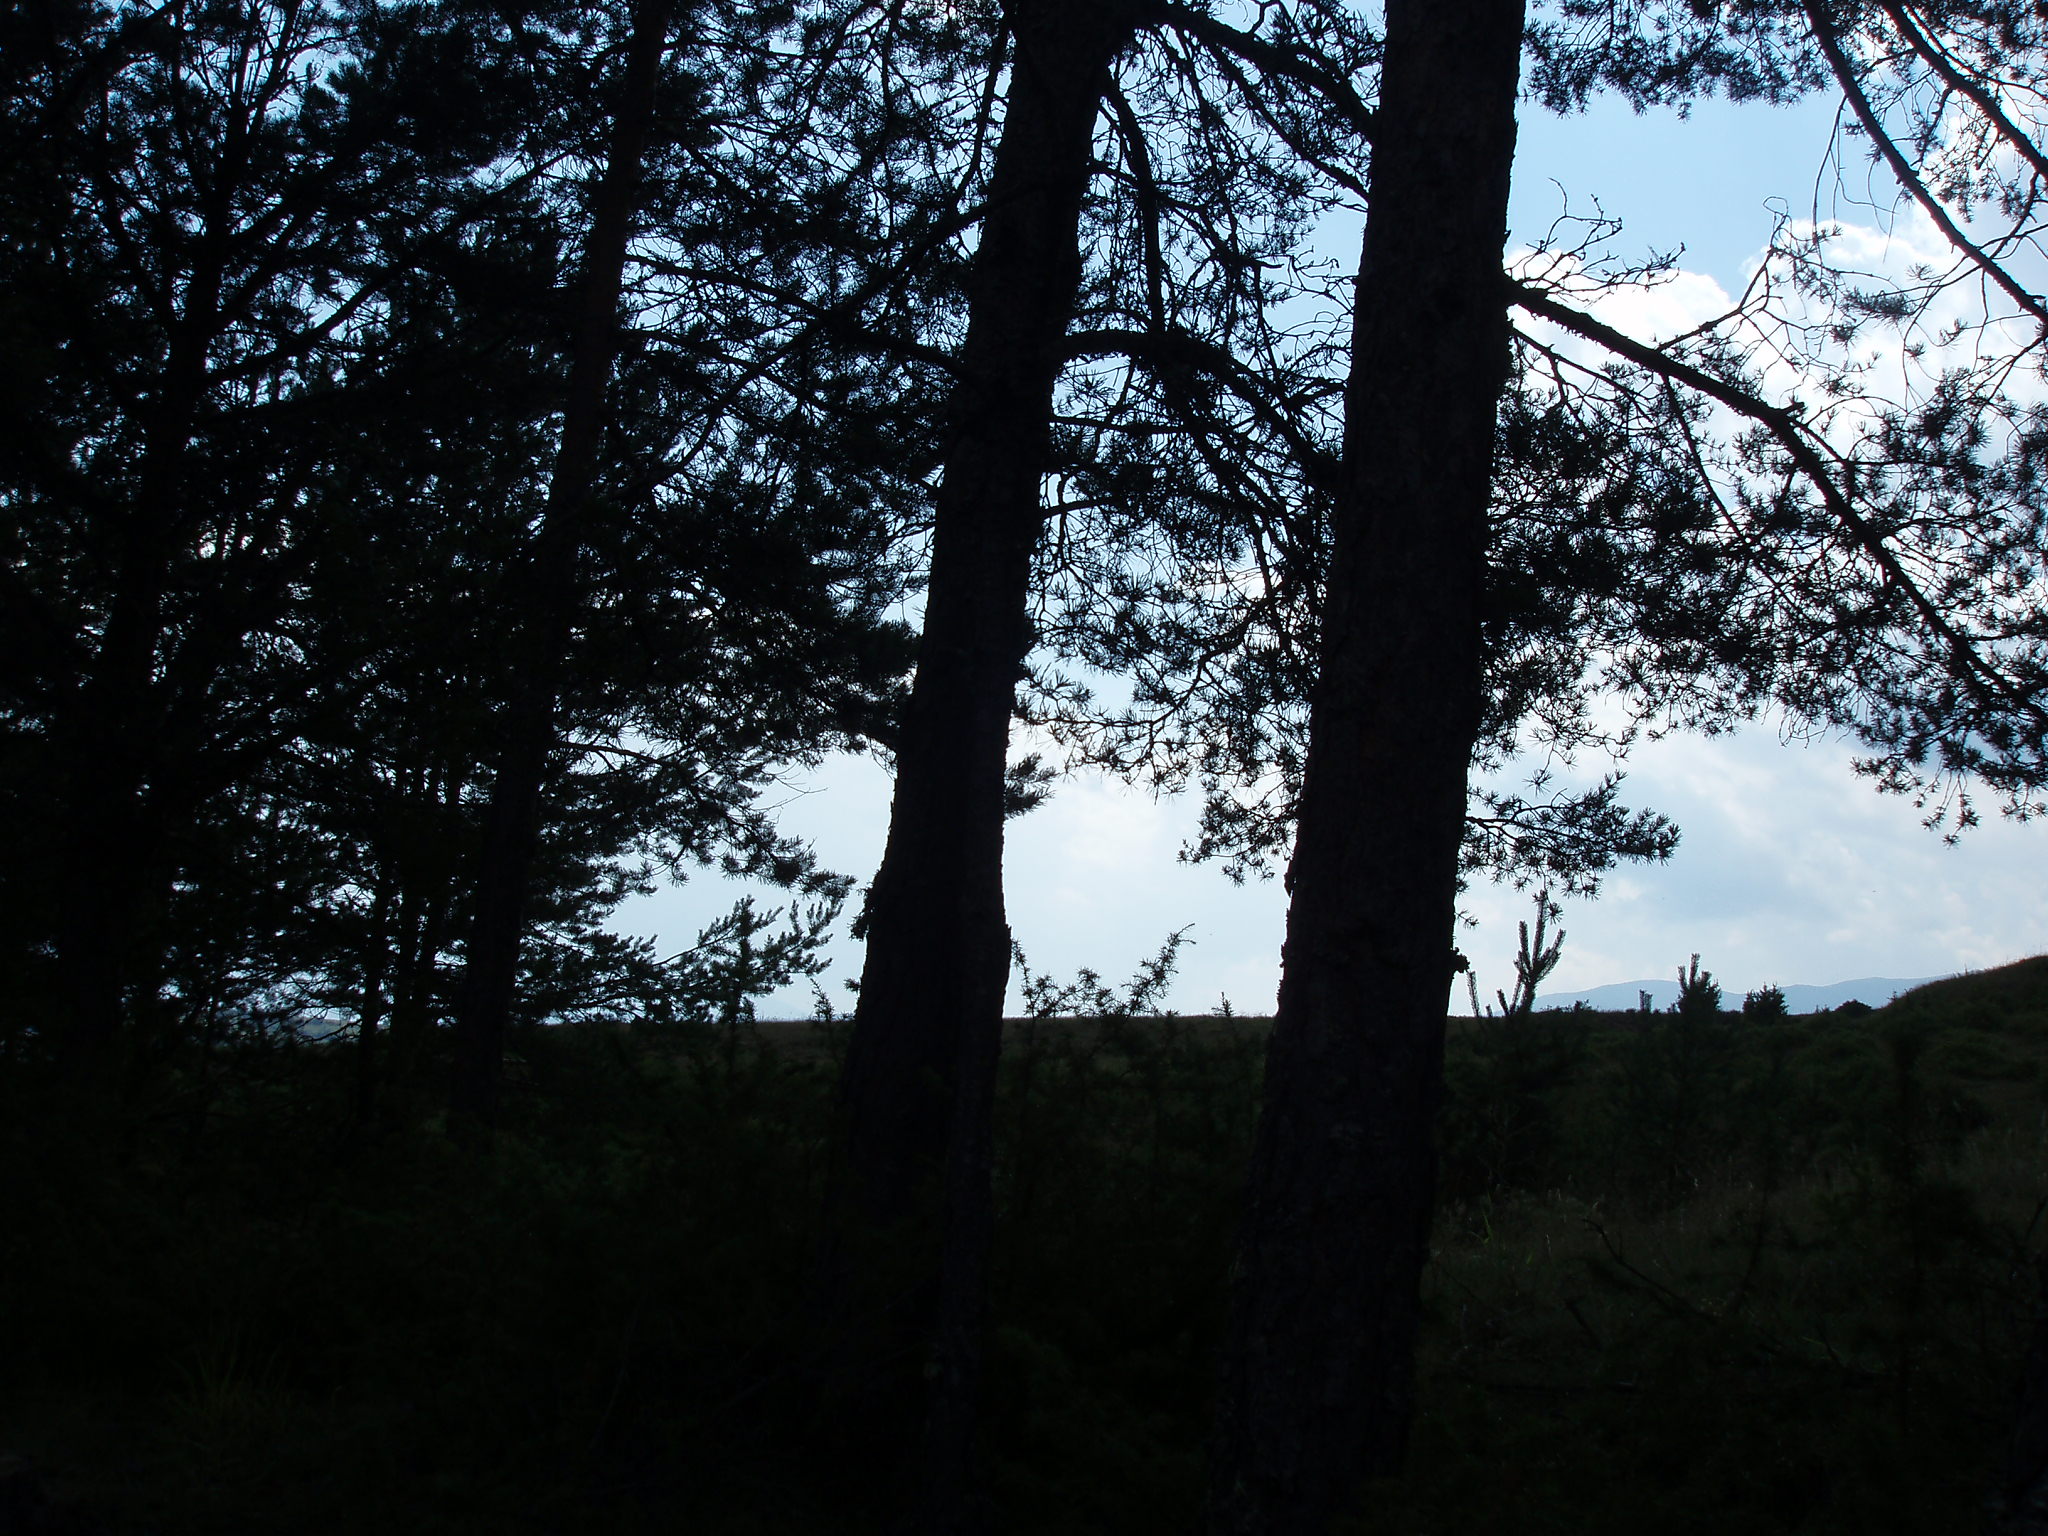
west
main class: Woodland
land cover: Pine dominated coniferous woodland
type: hemiboreal forest and nemoral coniferous forest and mixed broadleaved-coniferous forest
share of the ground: > 75 %
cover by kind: coniferous forest trees 90 %, unconsolidated bare surface 10 %
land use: Forestry
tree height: > 5 m
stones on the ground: 10 - 25 %
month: July
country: BG
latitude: 41.9641
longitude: 23.5071
